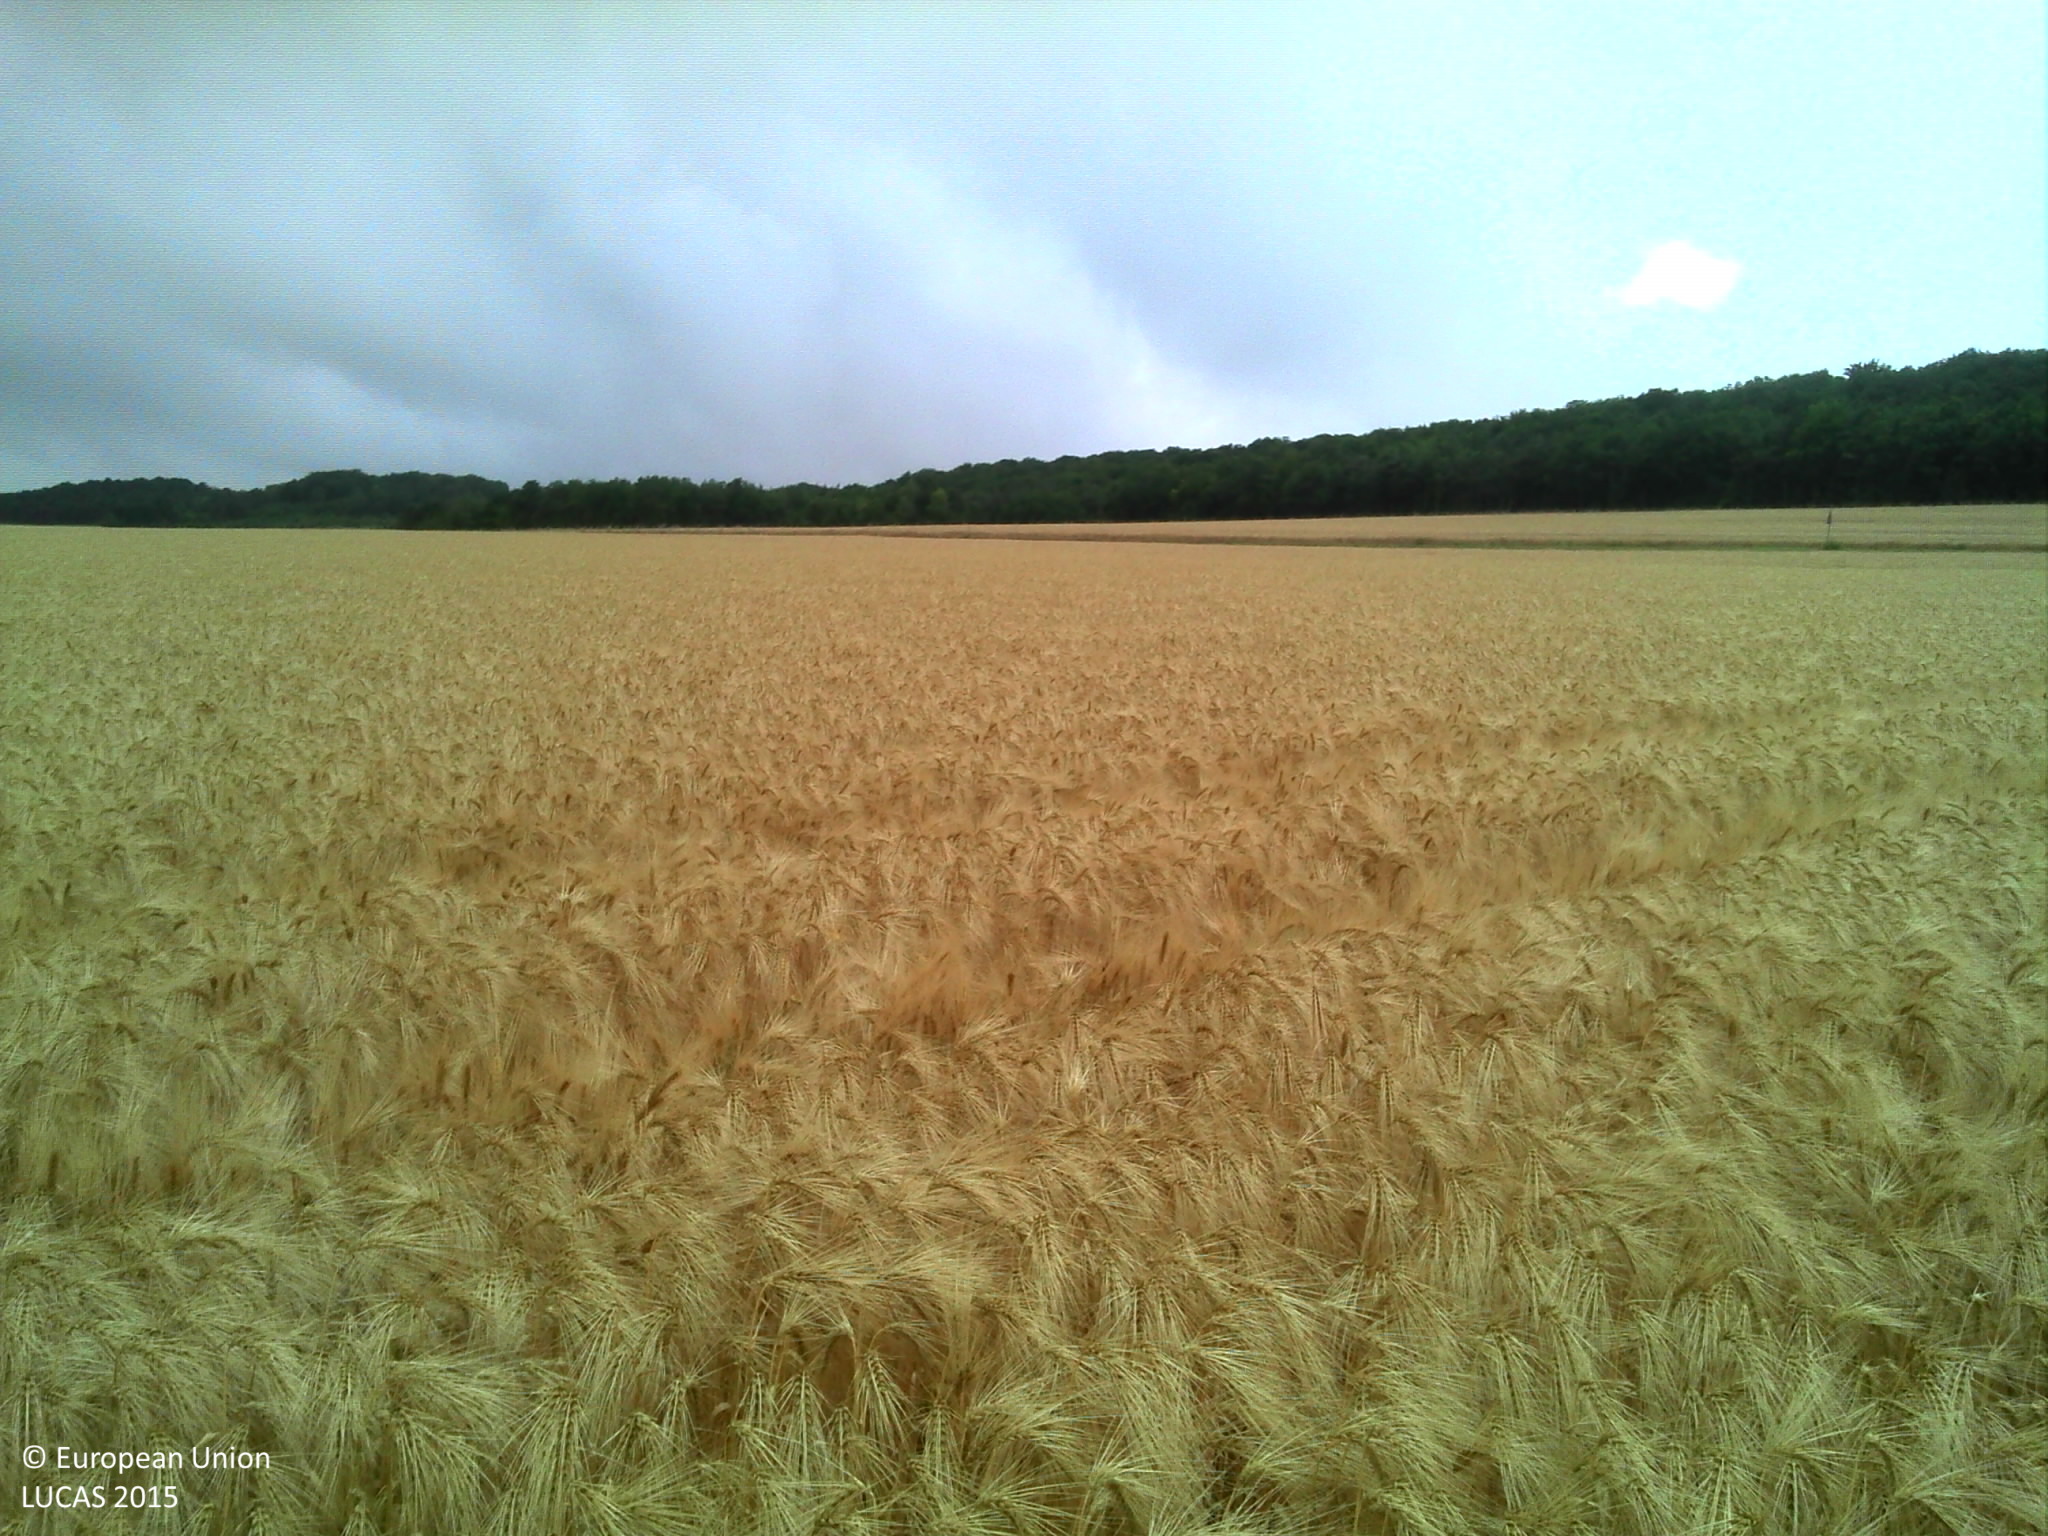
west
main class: Cropland
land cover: Barley
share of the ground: > 75 %
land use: Agriculture (excluding fallow land and kitchen gardens)
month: June
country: FR
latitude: 48.3194
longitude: 3.4806
